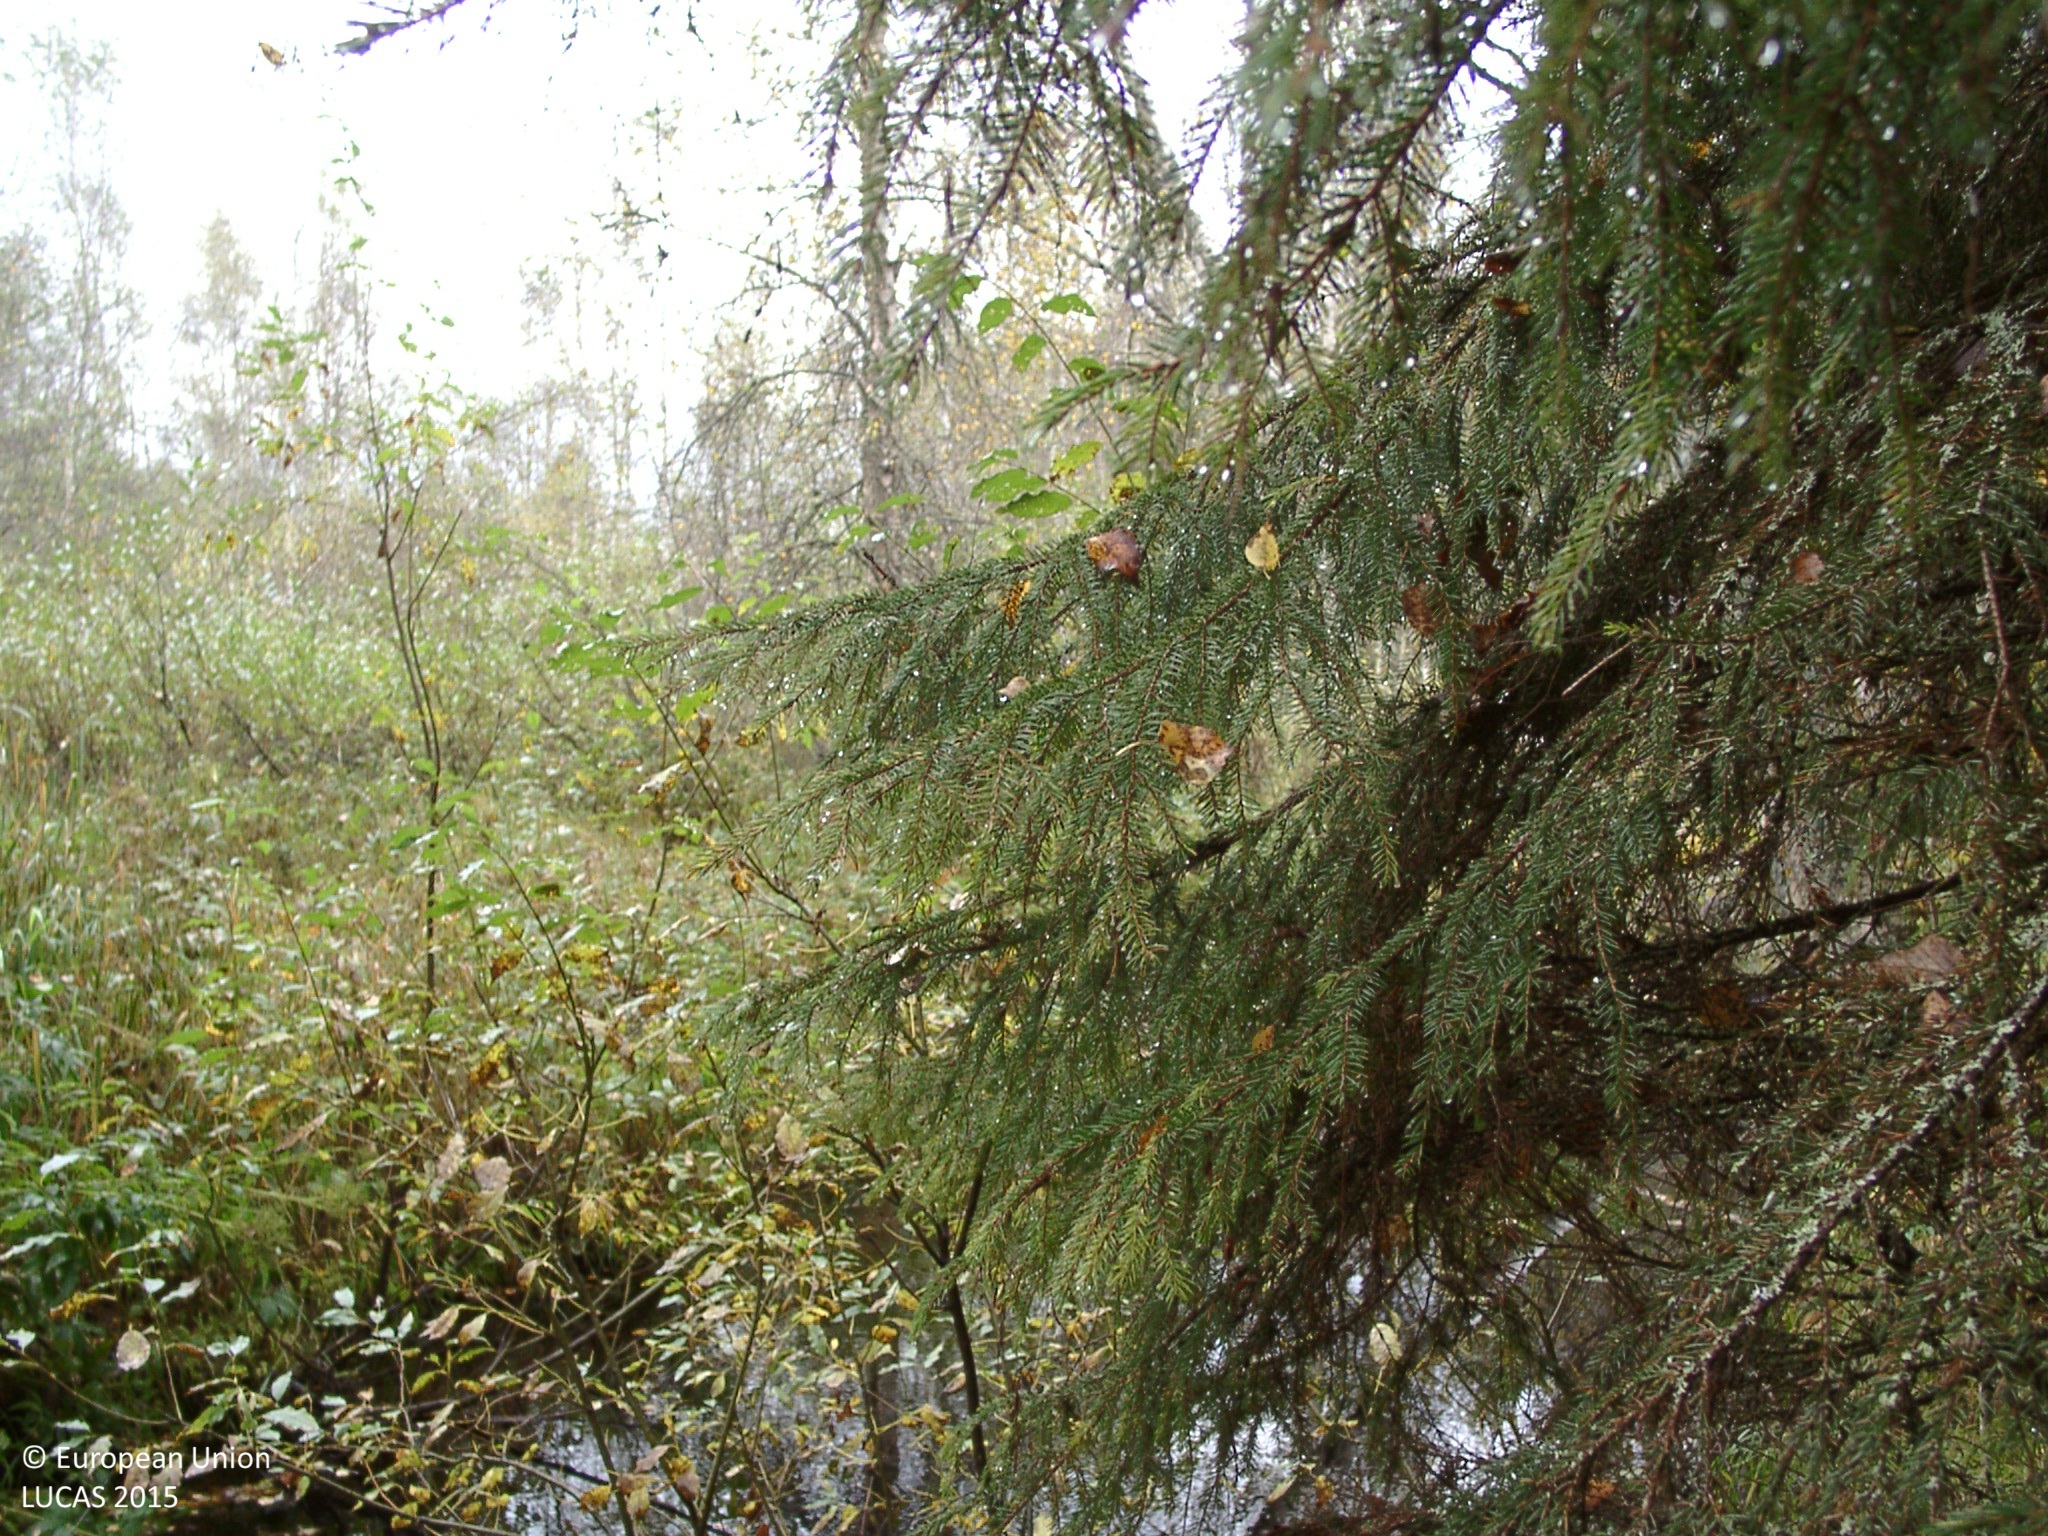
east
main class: Shrubland
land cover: Shrubland with sparse tree cover
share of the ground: 25 - 50 %
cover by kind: herbaceous plants 55 %, shrubs 40 %, broadleaved forest trees 5 %
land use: Forestry
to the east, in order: Shrubland with sparse tree cover; Ditches and canals; Broadleaved woodland; Ditches and canals; Broadleaved woodland; Ditches and canals; Broadleaved woodland; Ditches and canals; Broadleaved woodland; Ditches and canals; Broadleaved woodland; Ditches and canals; Shrubland with sparse tree cover; Ditches and canals; Shrubland with sparse tree cover; Ditches and canals; Broadleaved woodland; Ditches and canals; Broadleaved woodland; Ditches and canals; Other mixed woodland
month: September
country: FI
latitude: 62.7441
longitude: 25.3129
